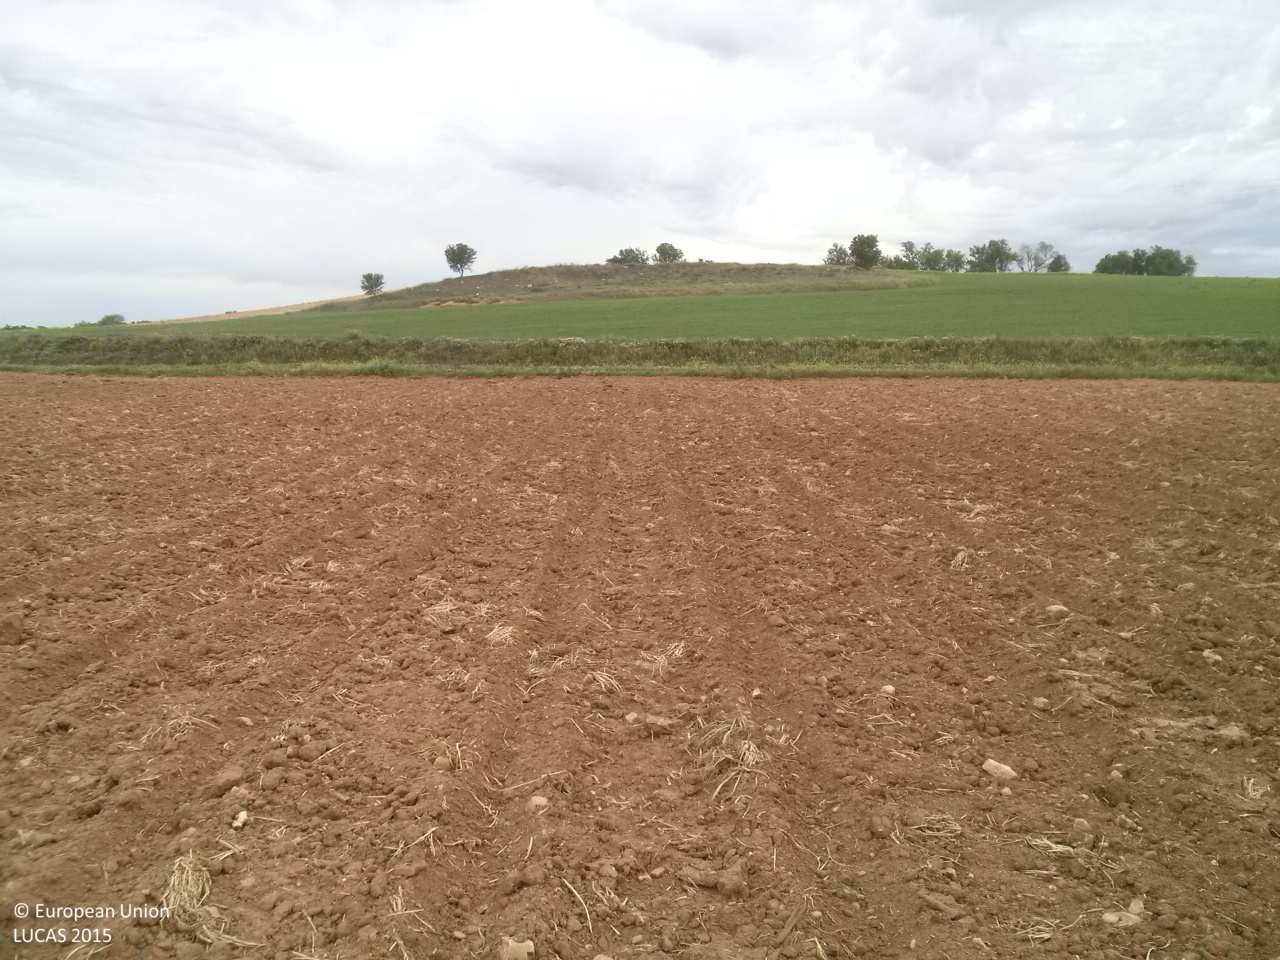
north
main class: Cropland
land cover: Sunflower
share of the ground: < 10 %
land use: Agriculture (excluding fallow land and kitchen gardens)
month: May
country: ES
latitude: 39.9089
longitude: -2.8769
